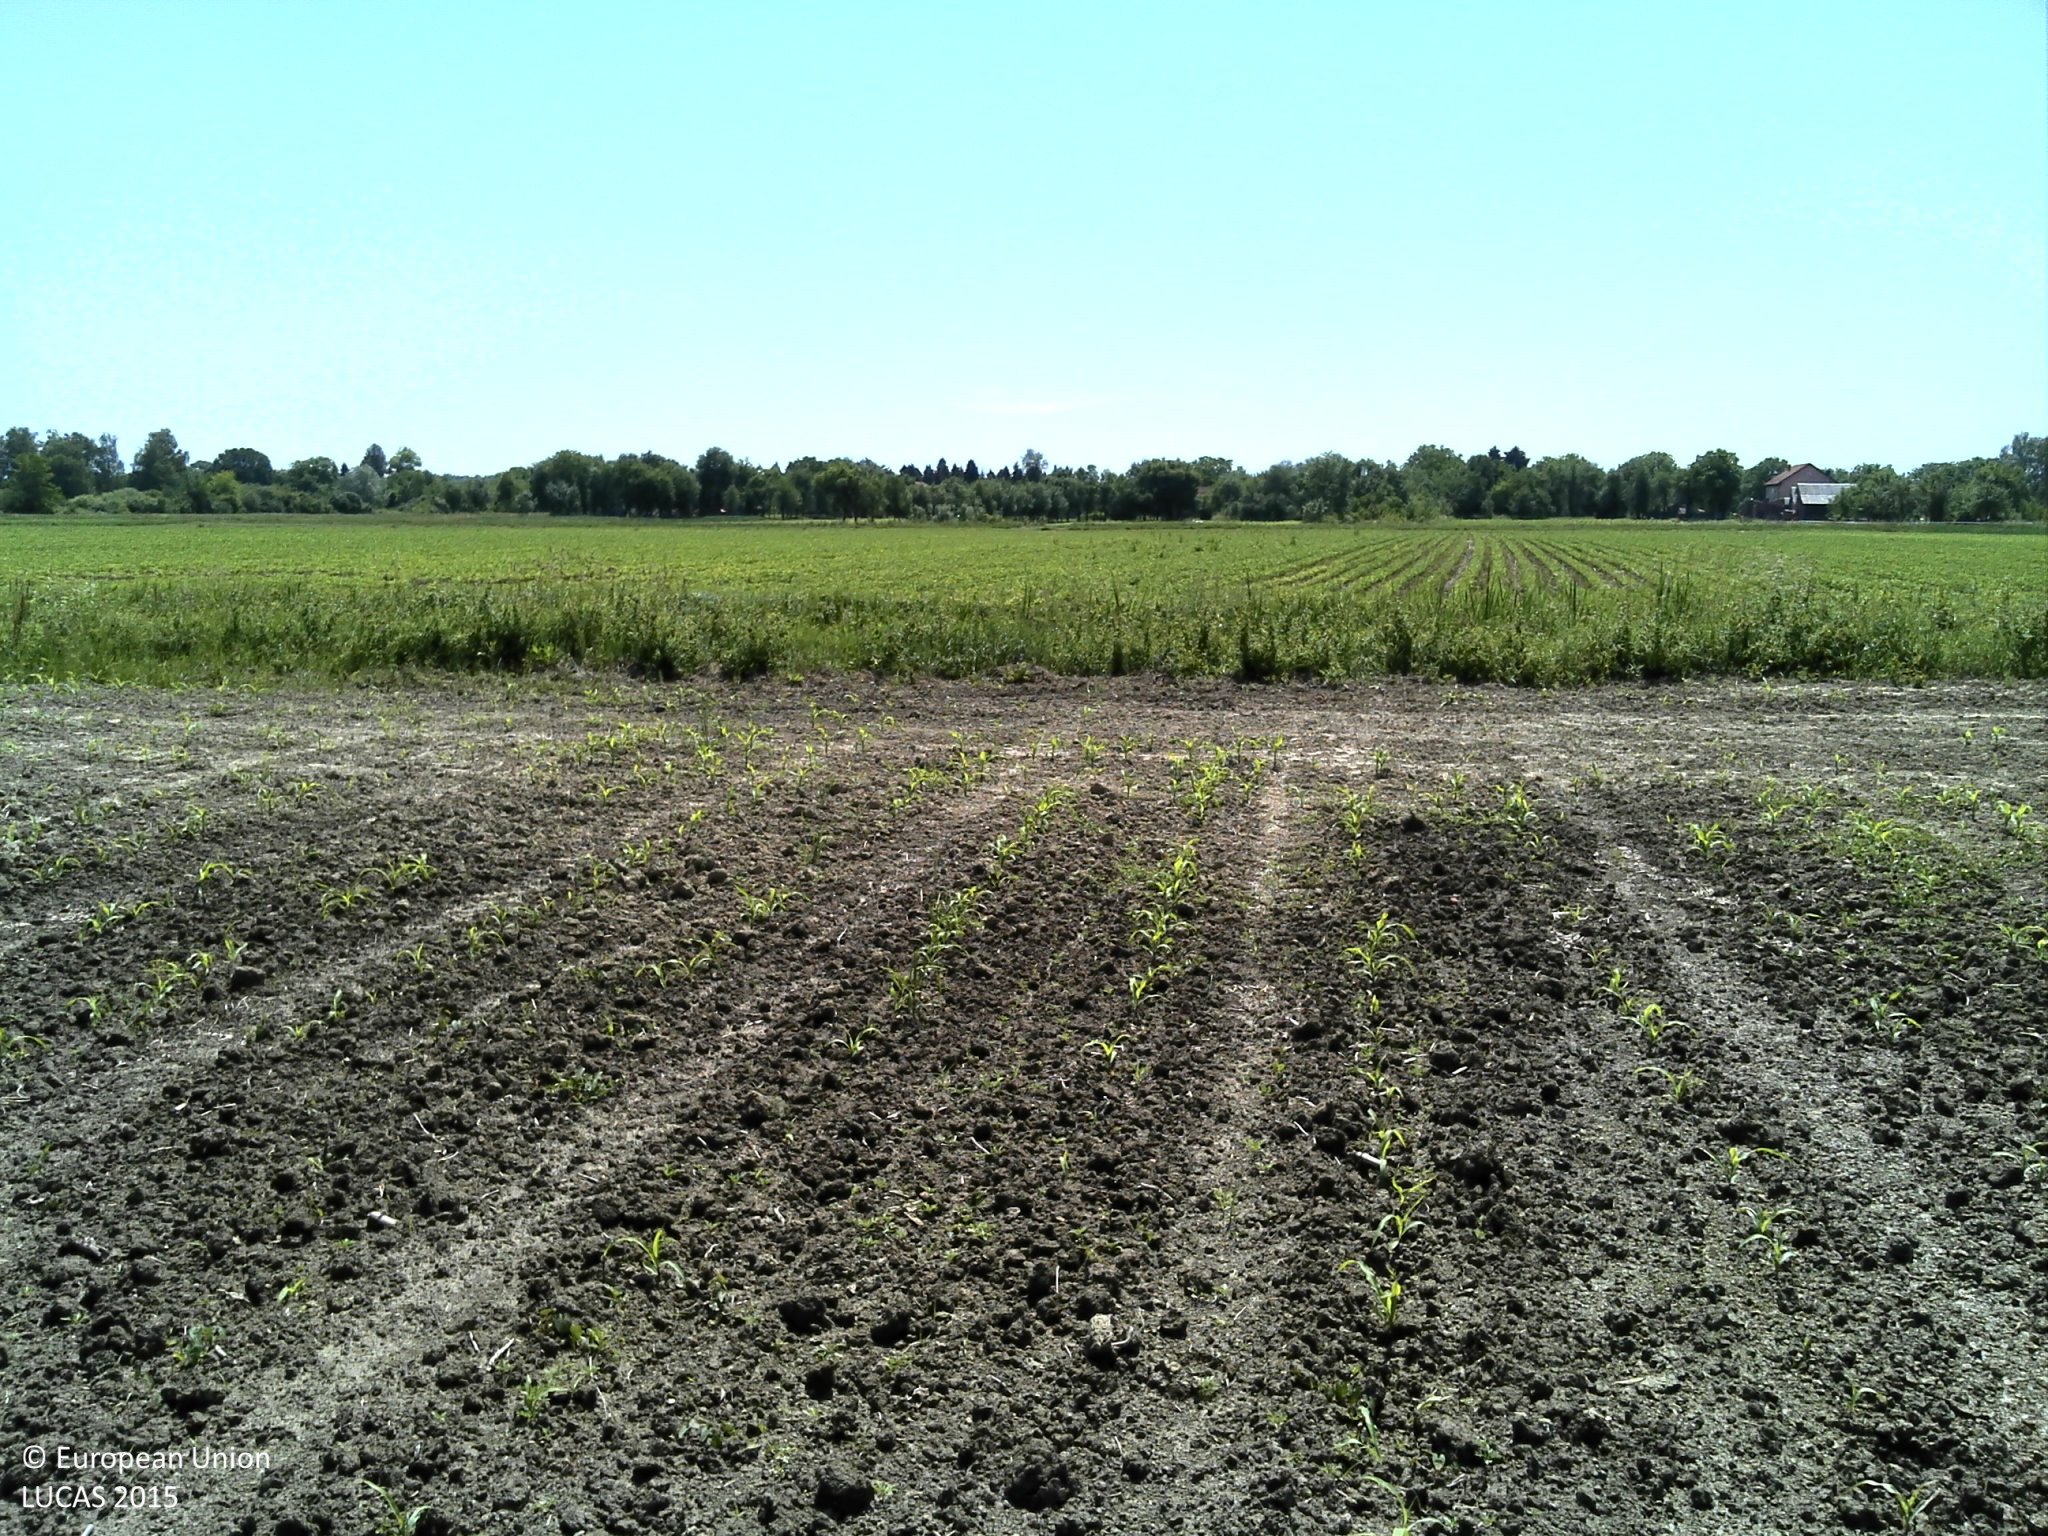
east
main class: Cropland
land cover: Maize
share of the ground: < 10 %
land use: Agriculture (excluding fallow land and kitchen gardens)
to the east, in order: Maize; Ditches and canals; Soya; Common wheat; Ditches and canals; Grass margins; Tracks; Common wheat
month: May
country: HR
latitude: 45.6193
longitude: 17.9682
